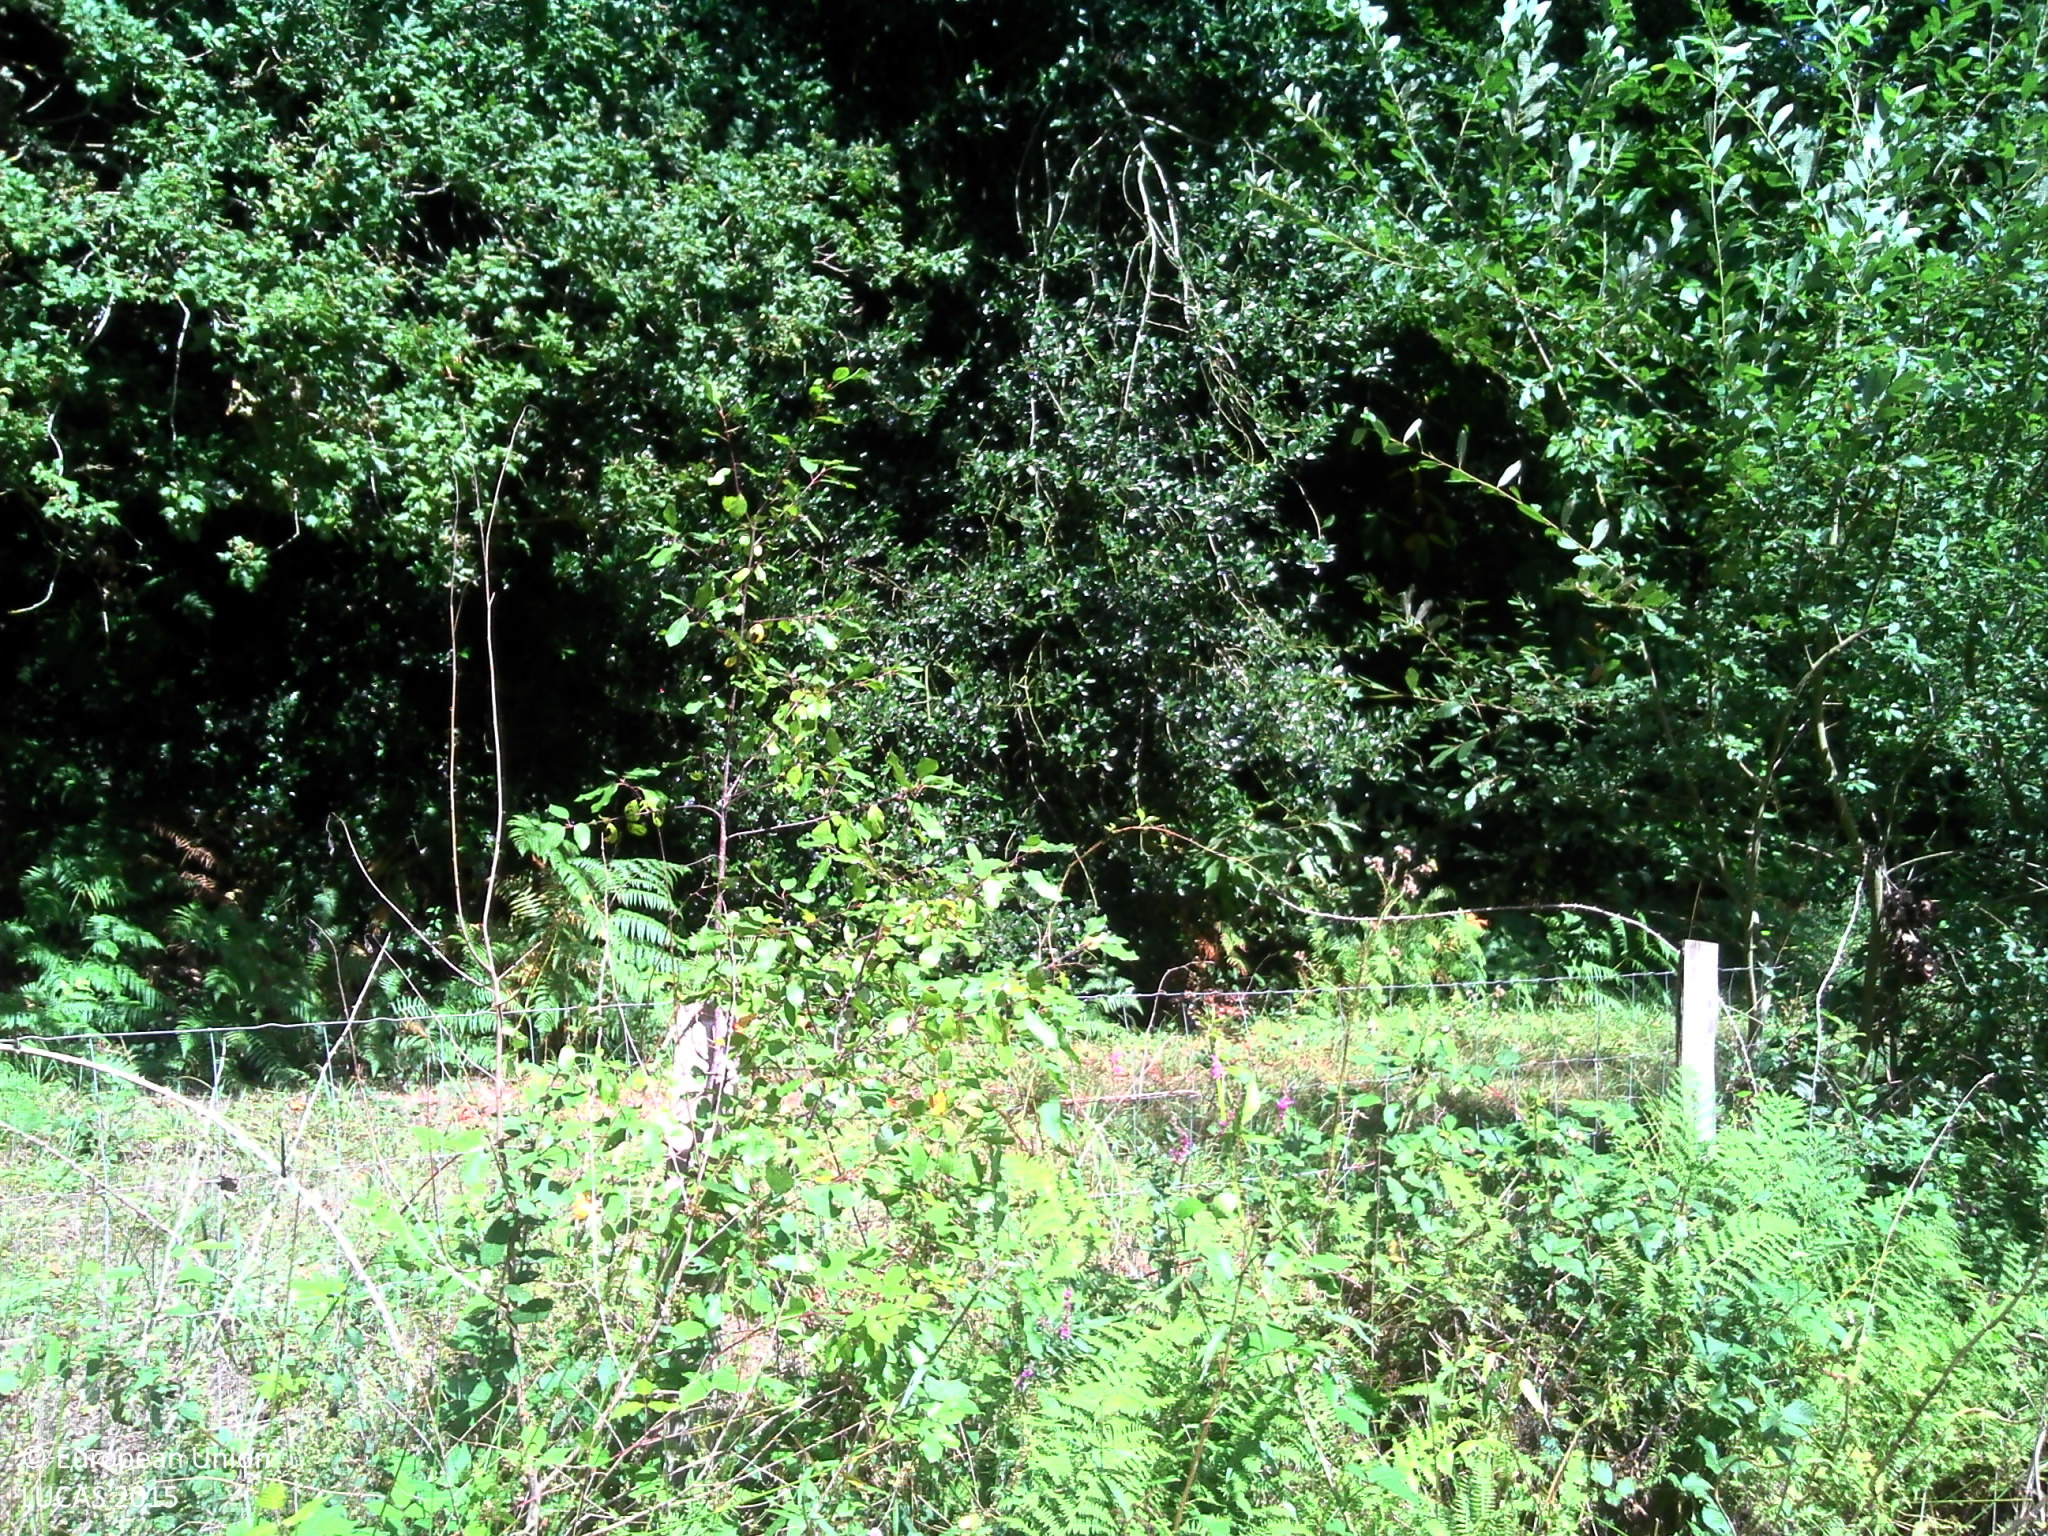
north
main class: Grassland
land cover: Grassland without tree/shrub cover
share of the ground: > 75 %
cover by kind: herbaceous plants 100 %
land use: Agriculture (excluding fallow land and kitchen gardens)
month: August
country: FR
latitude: 47.7840
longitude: -2.3218
